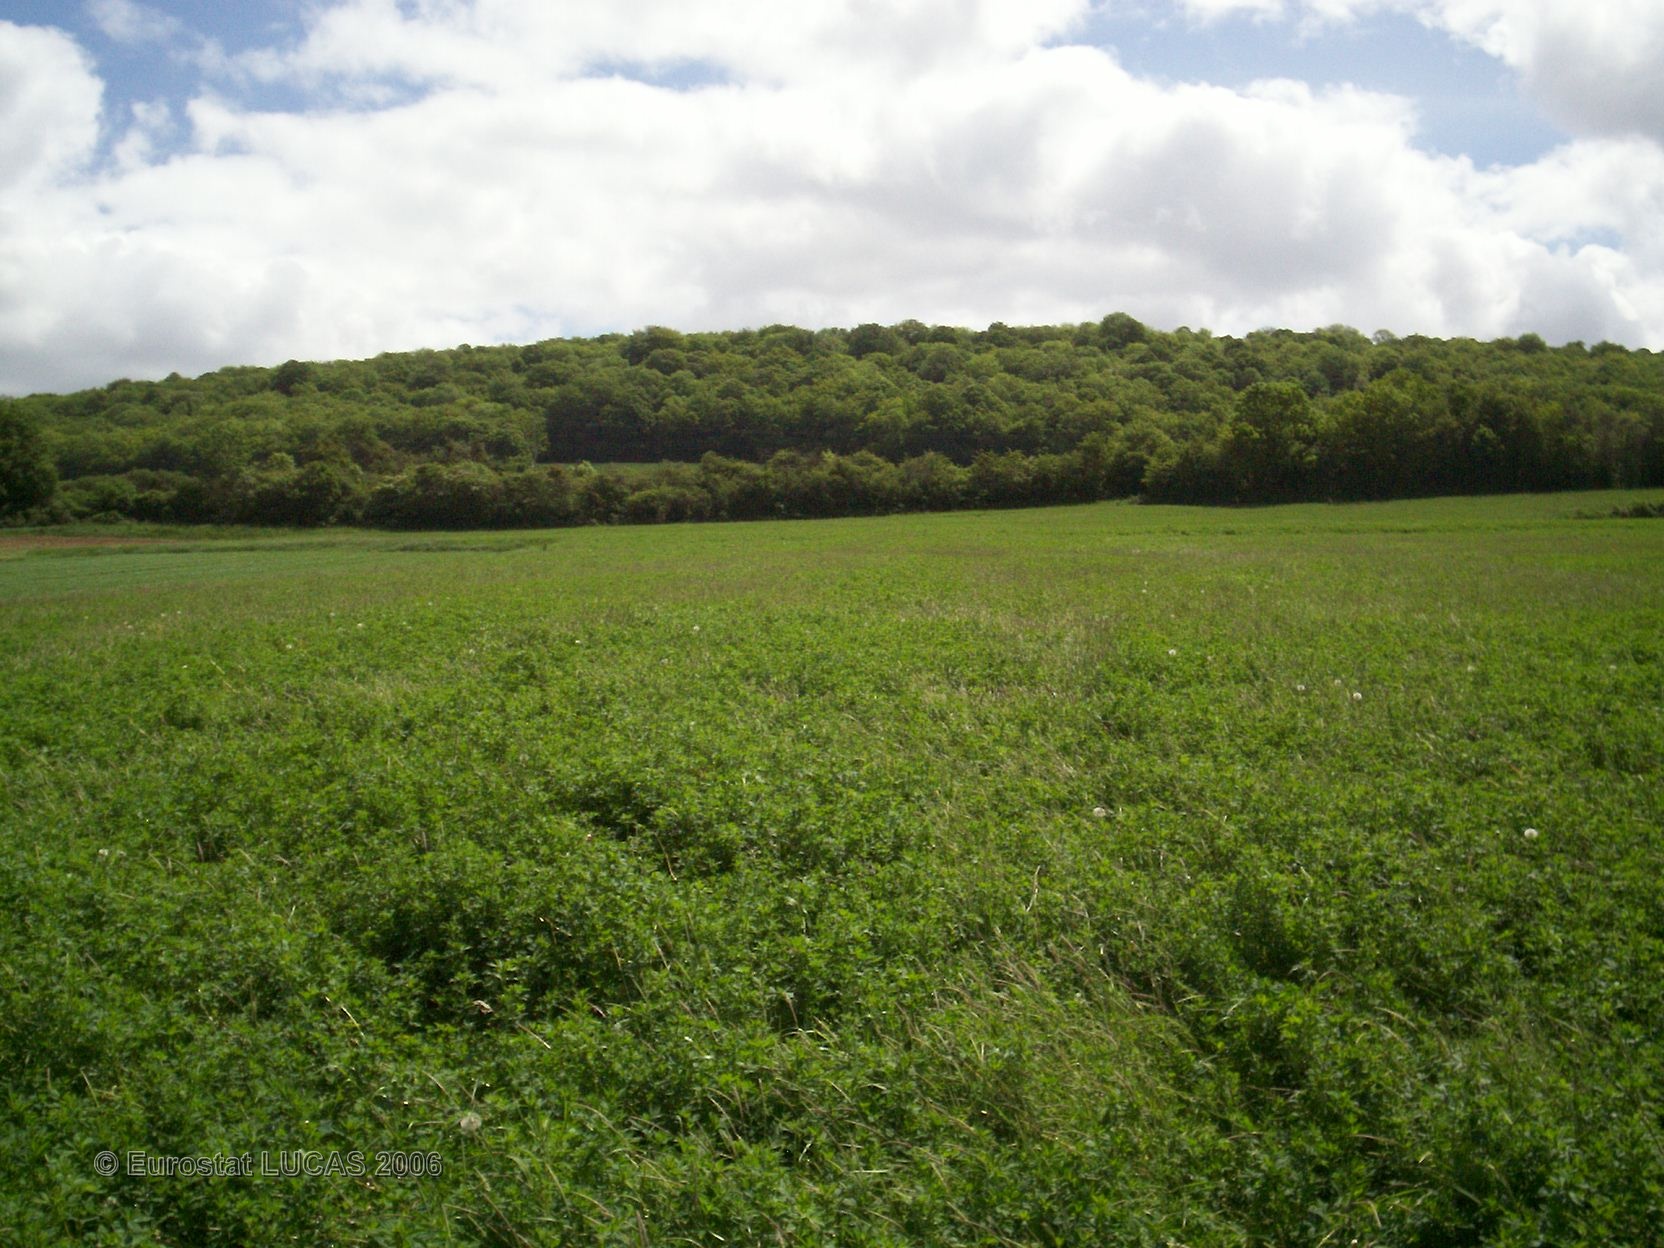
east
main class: Cropland
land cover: Lucerne
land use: Agriculture (excluding fallow land and kitchen gardens)
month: May
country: FR
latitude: 47.0471
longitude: 4.6431
